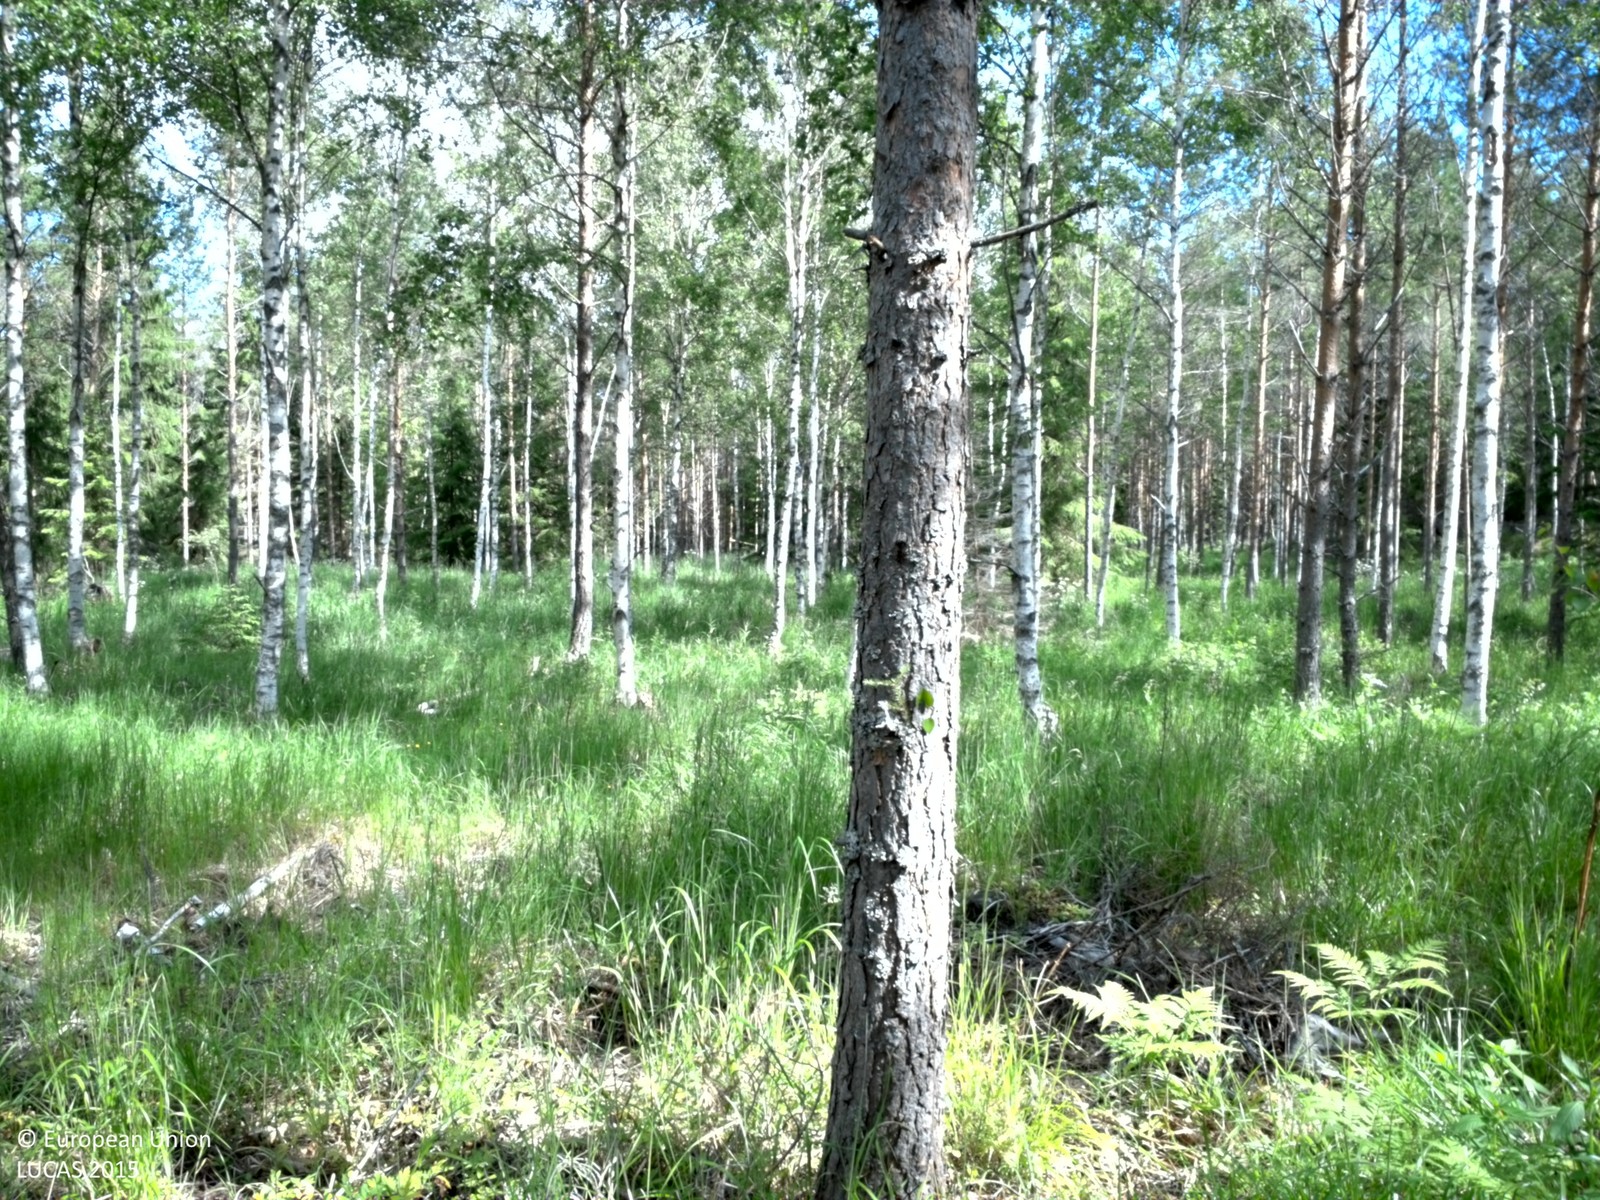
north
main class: Woodland
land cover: Pine dominated mixed woodland
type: boreal forest
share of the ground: 50 - 75 %
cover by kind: coniferous forest trees 45 %, herbaceous plants 25 %, broadleaved forest trees 15 %, lichens and mosses 15 %
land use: Forestry
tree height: > 5 m
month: June
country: SE
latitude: 60.1091
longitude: 18.4338
